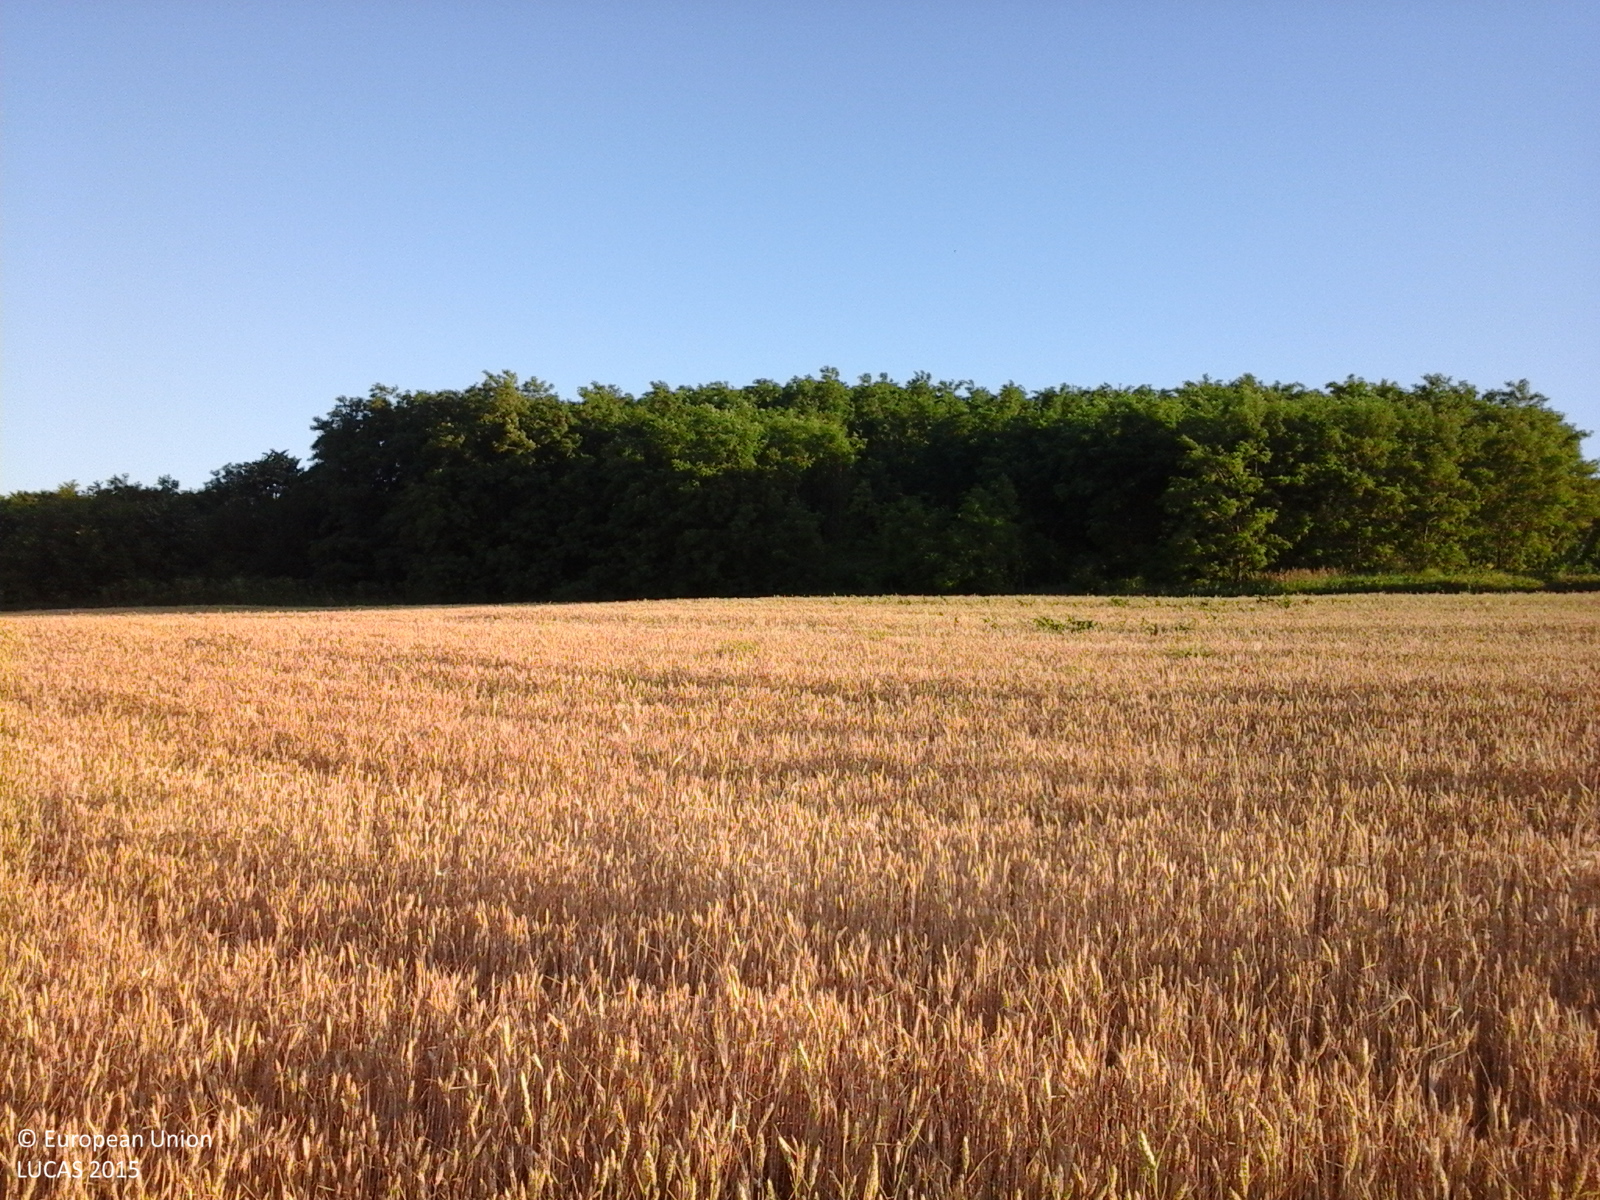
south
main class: Cropland
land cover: Common wheat
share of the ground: > 75 %
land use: Agriculture (excluding fallow land and kitchen gardens)
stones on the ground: < 10 %
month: June
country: RO
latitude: 46.9664
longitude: 27.9911
